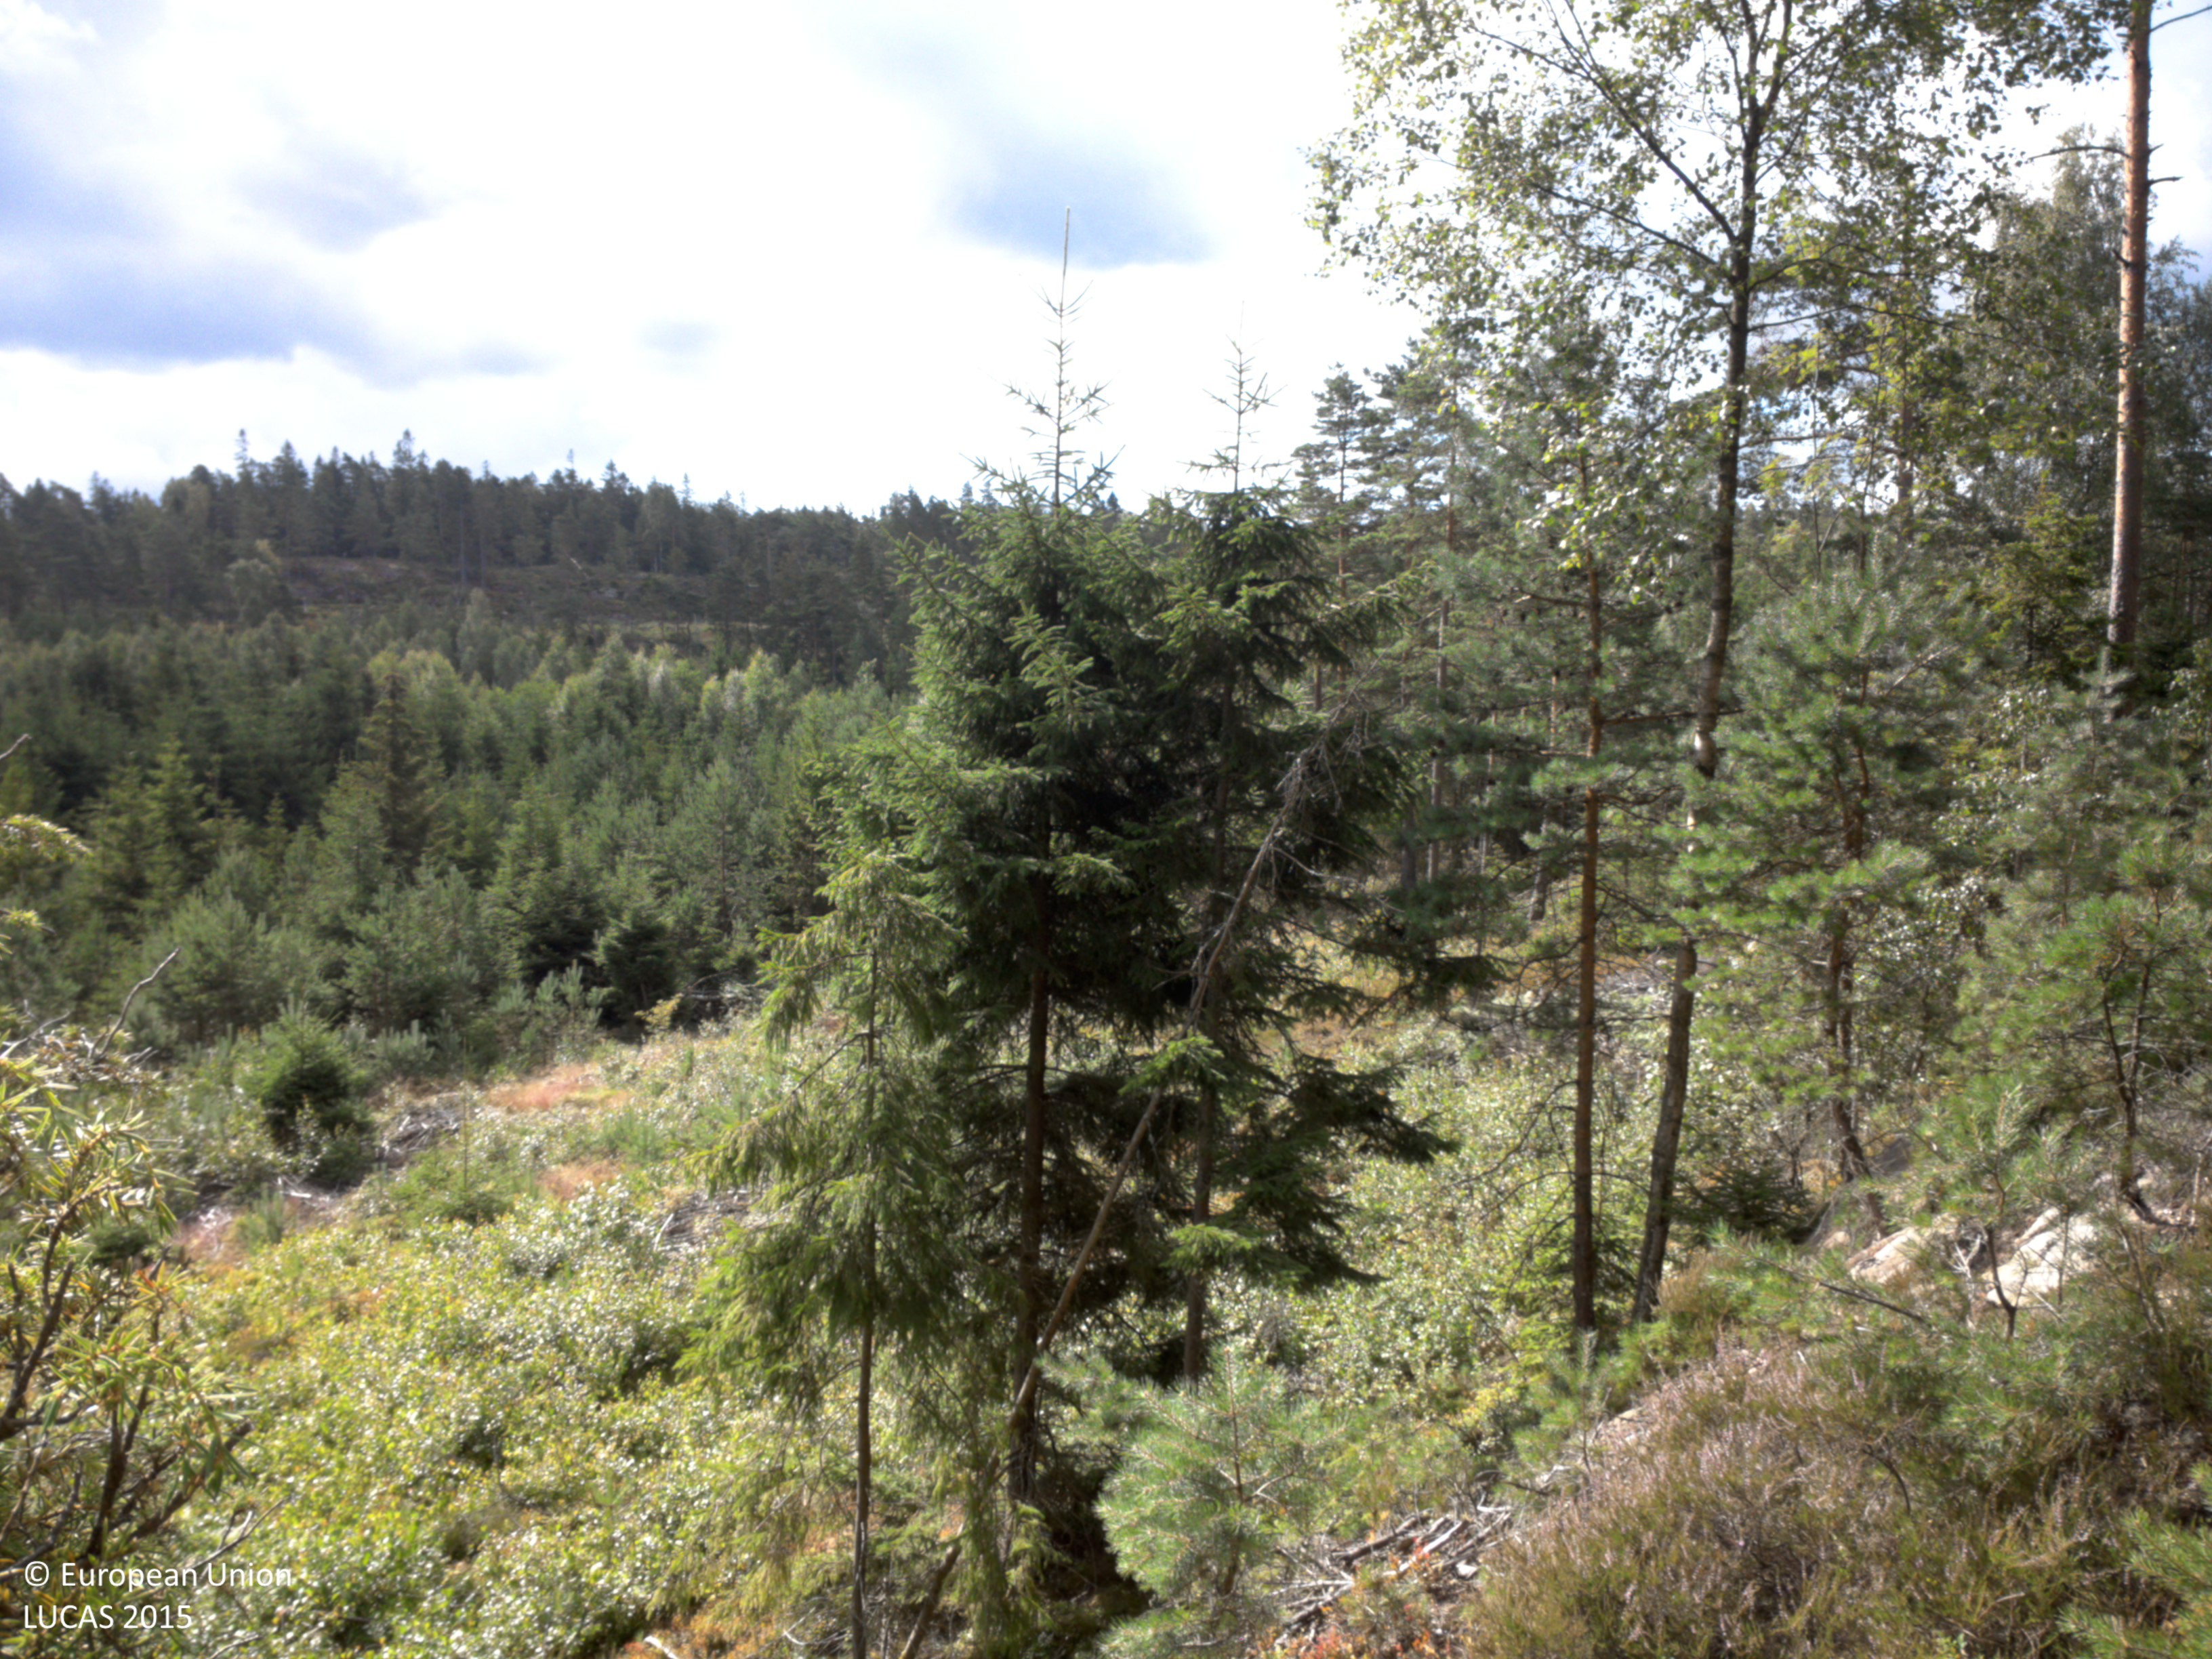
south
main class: Woodland
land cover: Other coniferous woodland
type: boreal forest
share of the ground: 25 - 50 %
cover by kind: coniferous forest trees 40 %, shrubs 35 %, lichens and mosses 10 %, unconsolidated bare surface 10 %, broadleaved forest trees 5 %
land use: Forestry
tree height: > 5 m
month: July
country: SE
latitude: 58.2436
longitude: 11.7852
